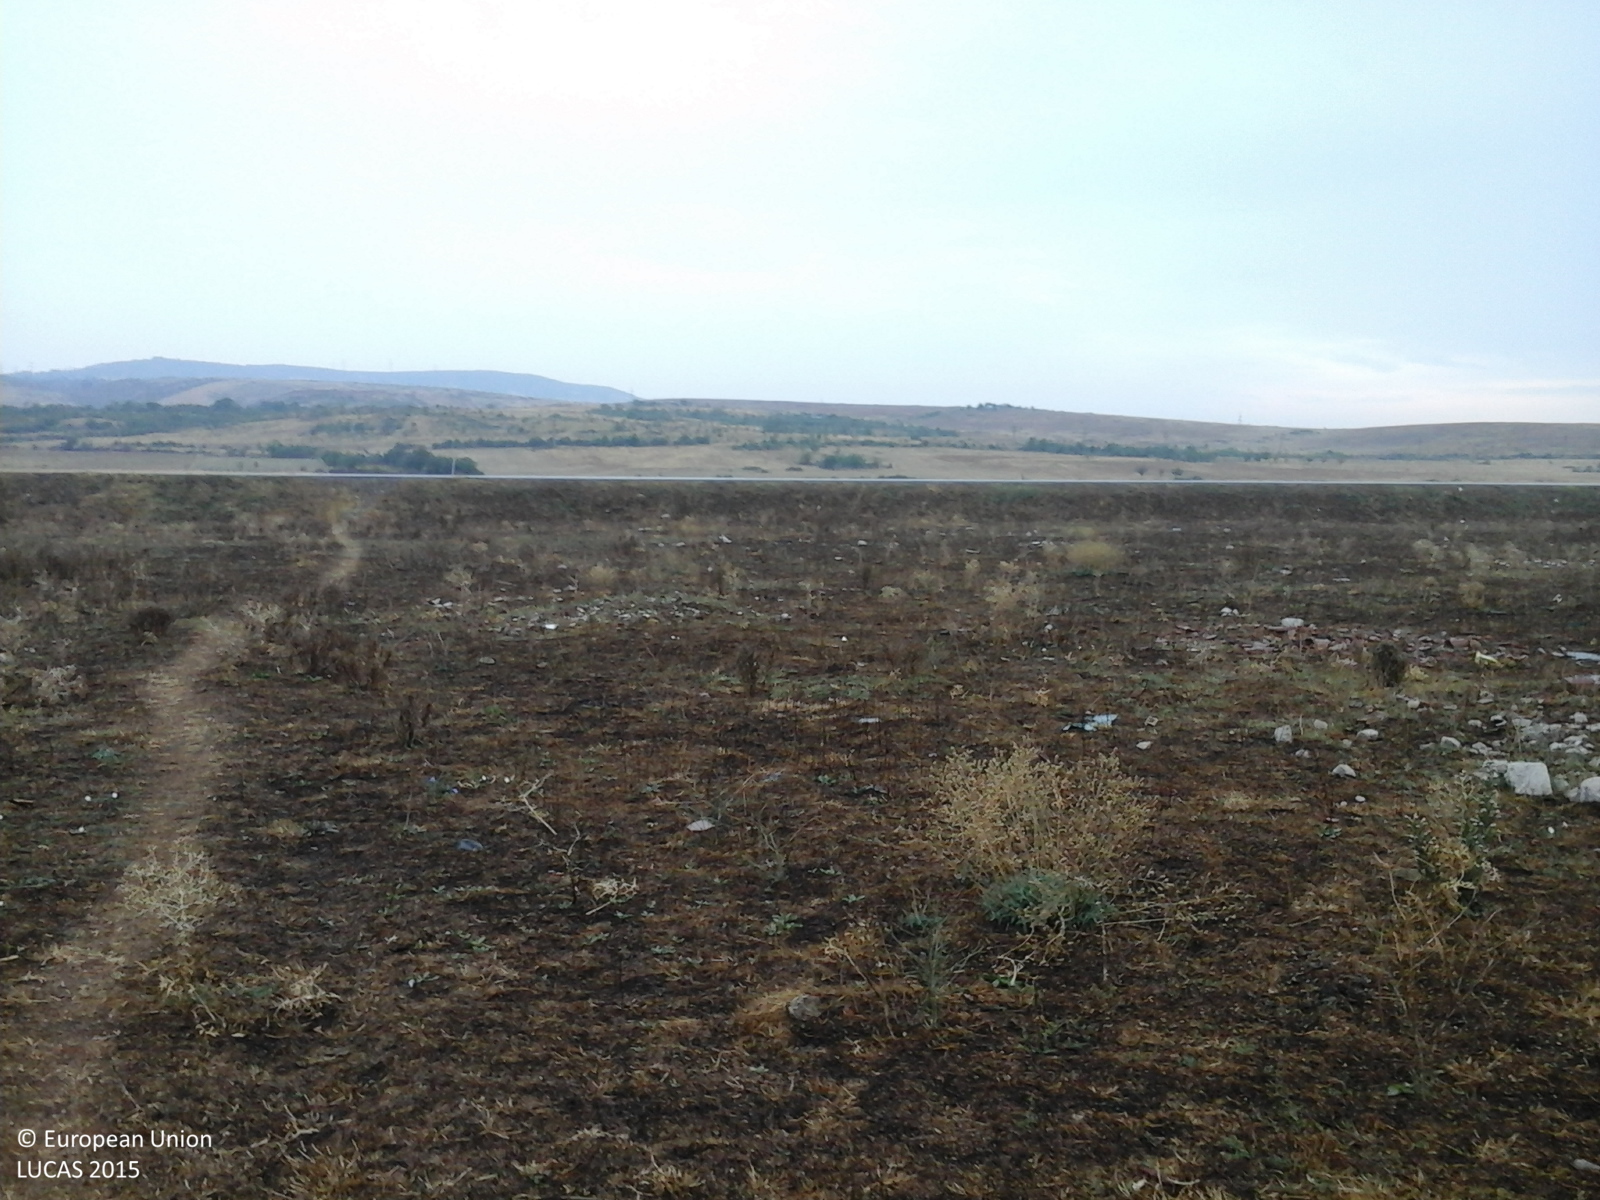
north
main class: Grassland
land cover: Spontaneously vegetated surfaces
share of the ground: 25 - 50 %
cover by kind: herbaceous plants 100 %
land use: Fallow land
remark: Burnt area
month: August
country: RO
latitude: 44.6356
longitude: 22.6093
